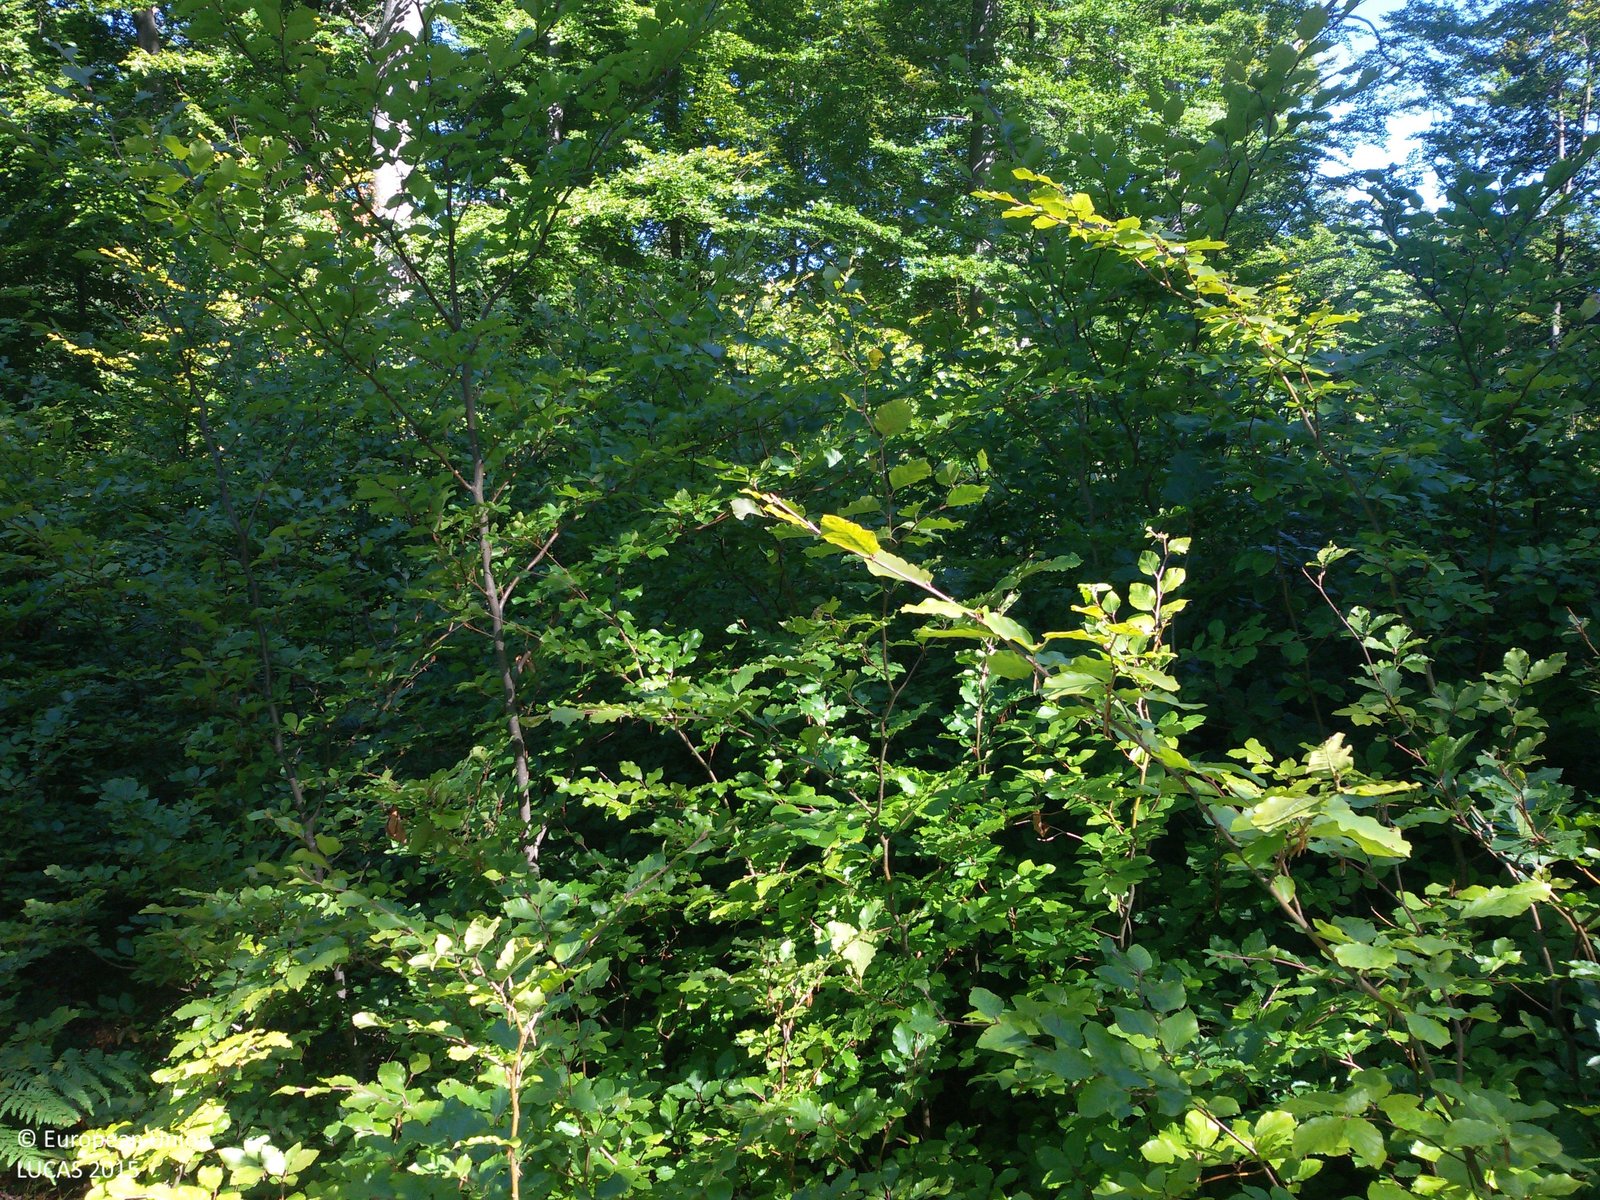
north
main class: Woodland
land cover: Broadleaved woodland
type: mesophytic deciduous forest
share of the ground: > 75 %
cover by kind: broadleaved forest trees 80 %, shrubs 15 %, herbaceous plants 5 %
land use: Forestry
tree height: > 5 m
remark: Nursery
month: August
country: PL
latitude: 54.1252
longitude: 17.2165
